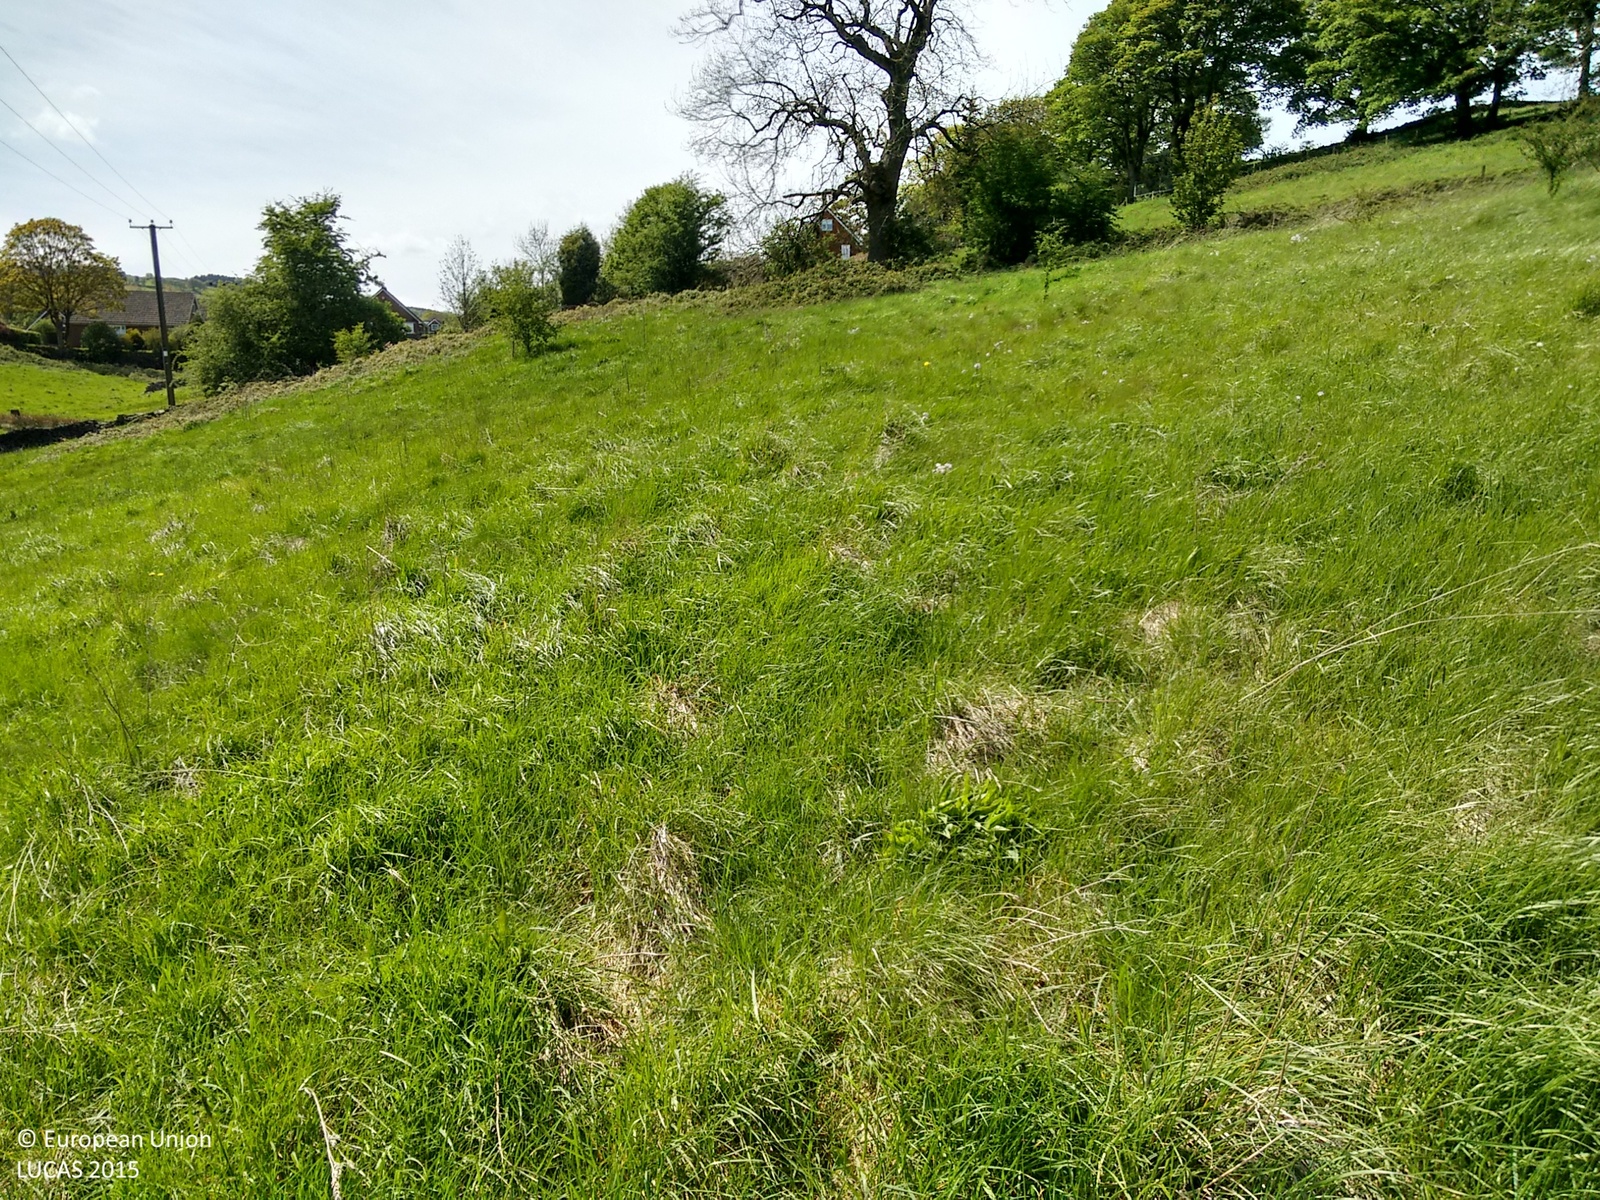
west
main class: Grassland
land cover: Grassland without tree/shrub cover
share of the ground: > 75 %
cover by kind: herbaceous plants 100 %
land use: Agriculture (excluding fallow land and kitchen gardens)
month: May
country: GB
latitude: 53.5869
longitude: -1.7919
